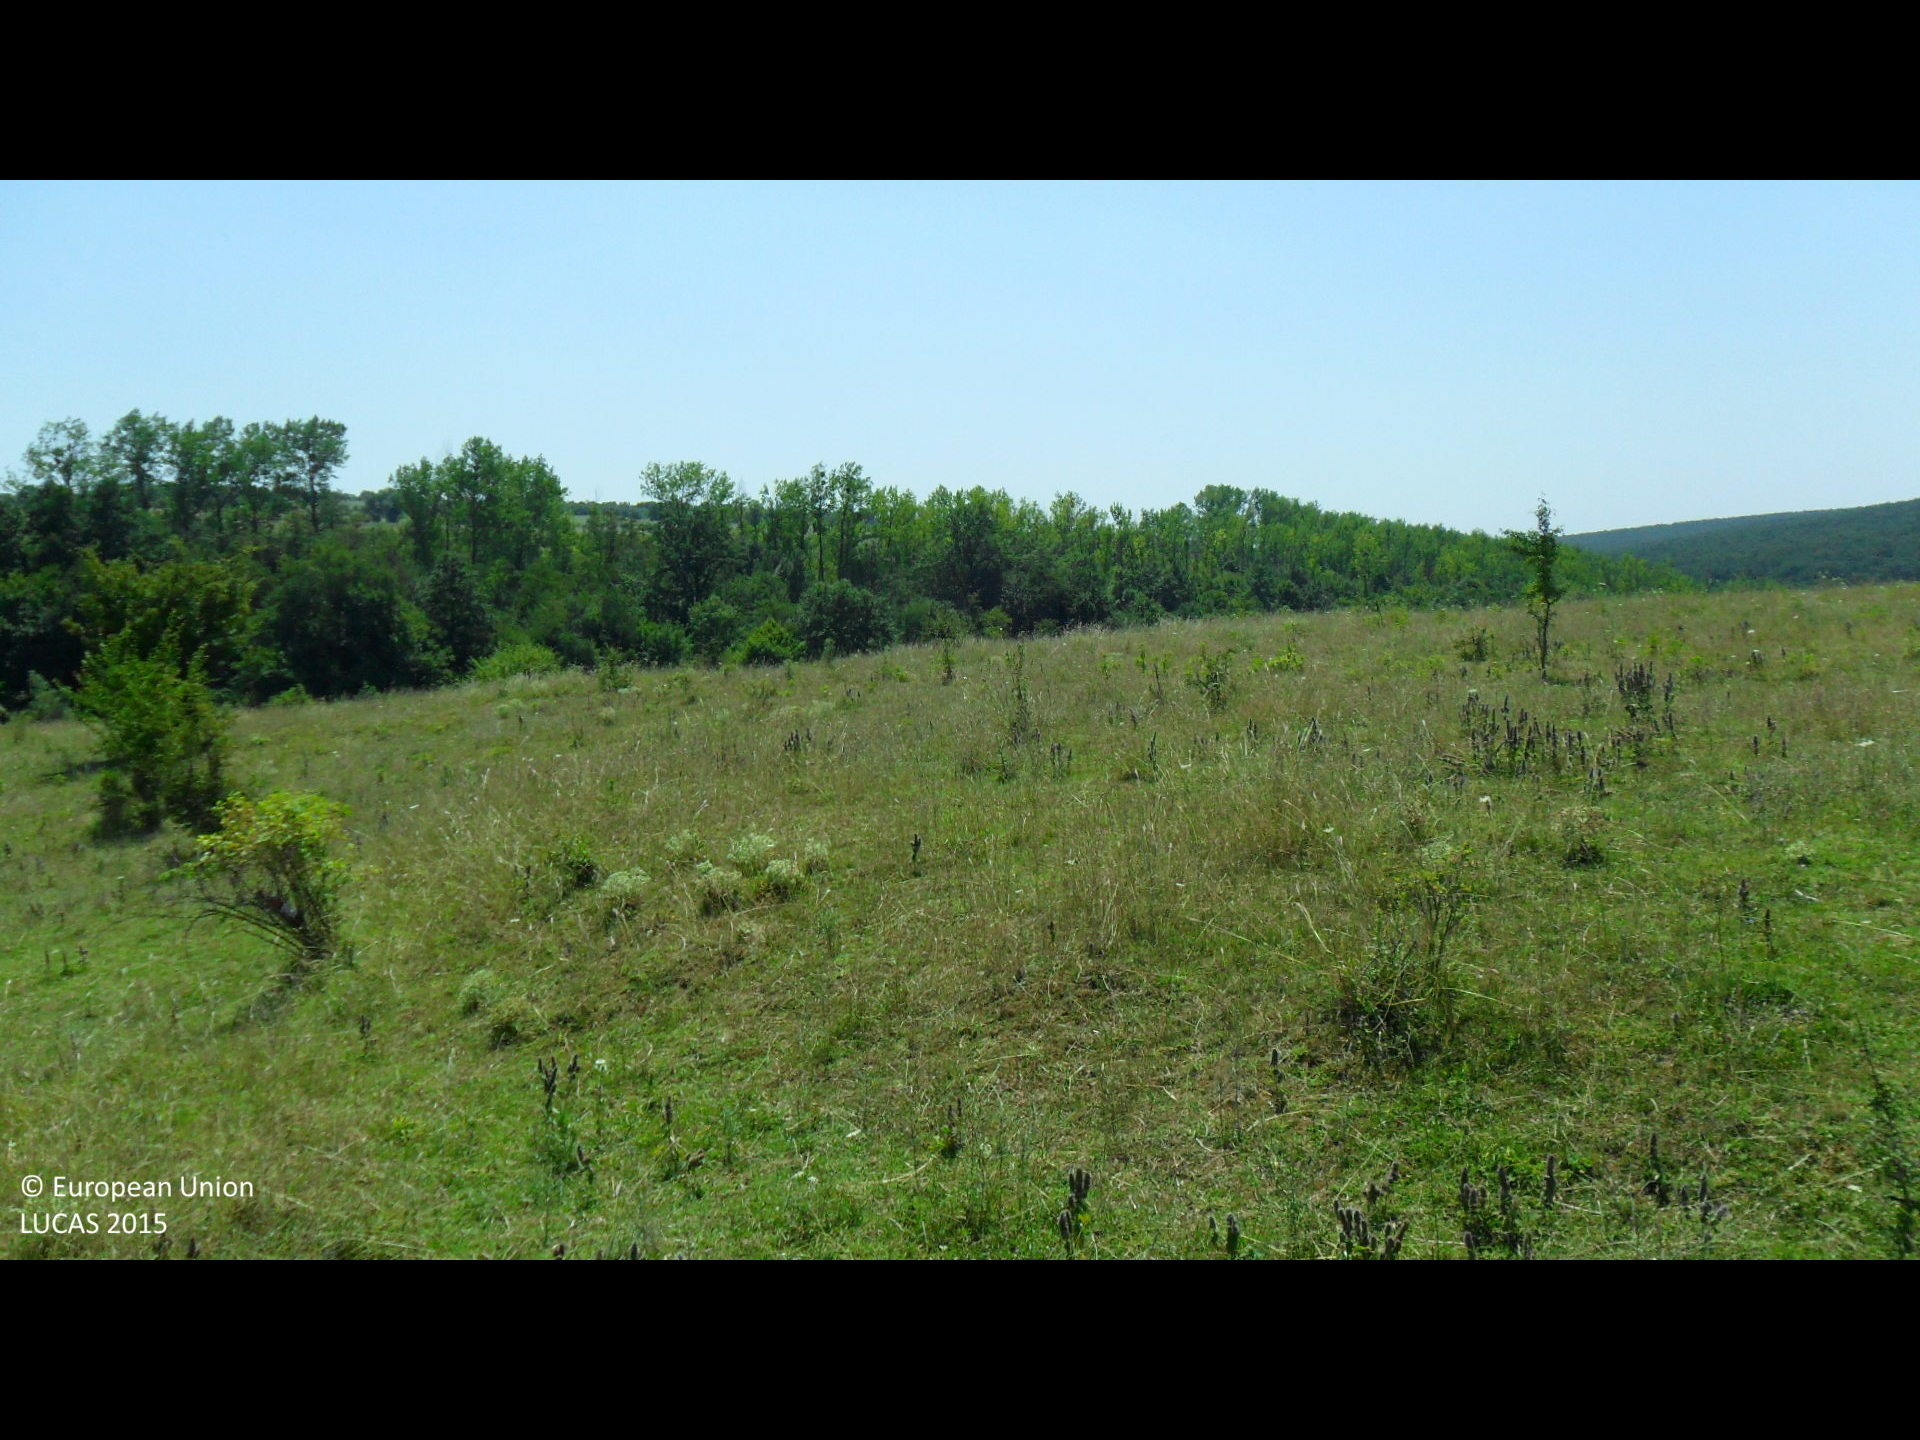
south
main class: Grassland
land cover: Grassland with sparse tree/shrub cover
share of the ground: > 75 %
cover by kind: herbaceous plants 90 %, broadleaved forest trees 5 %, shrubs 5 %
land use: Agriculture (excluding fallow land and kitchen gardens)
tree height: > 5 m
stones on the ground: < 10 %
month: August
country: BG
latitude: 43.3204
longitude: 26.1112
